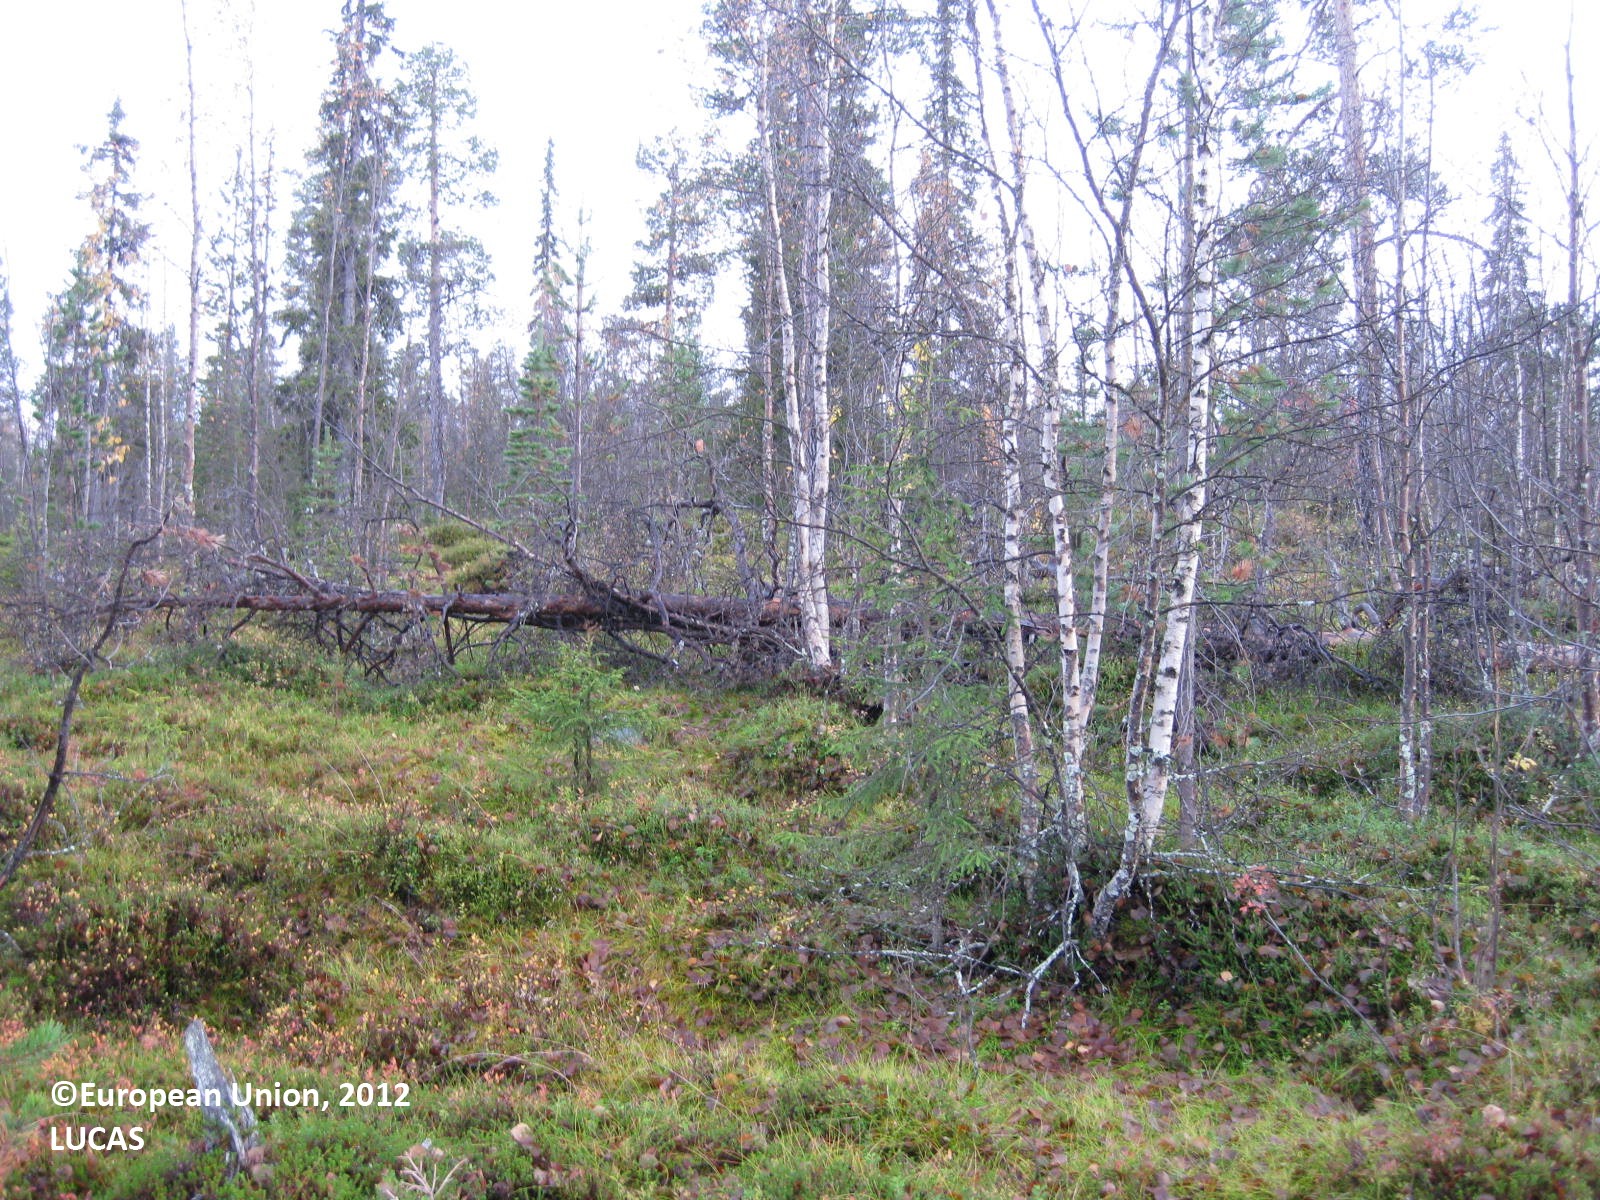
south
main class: Woodland
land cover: Other mixed woodland
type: boreal forest
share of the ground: 25 - 50 %
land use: Semi-natural and natural areas not in use
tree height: > 5 m
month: September
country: FI
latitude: 68.1526
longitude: 24.1504
